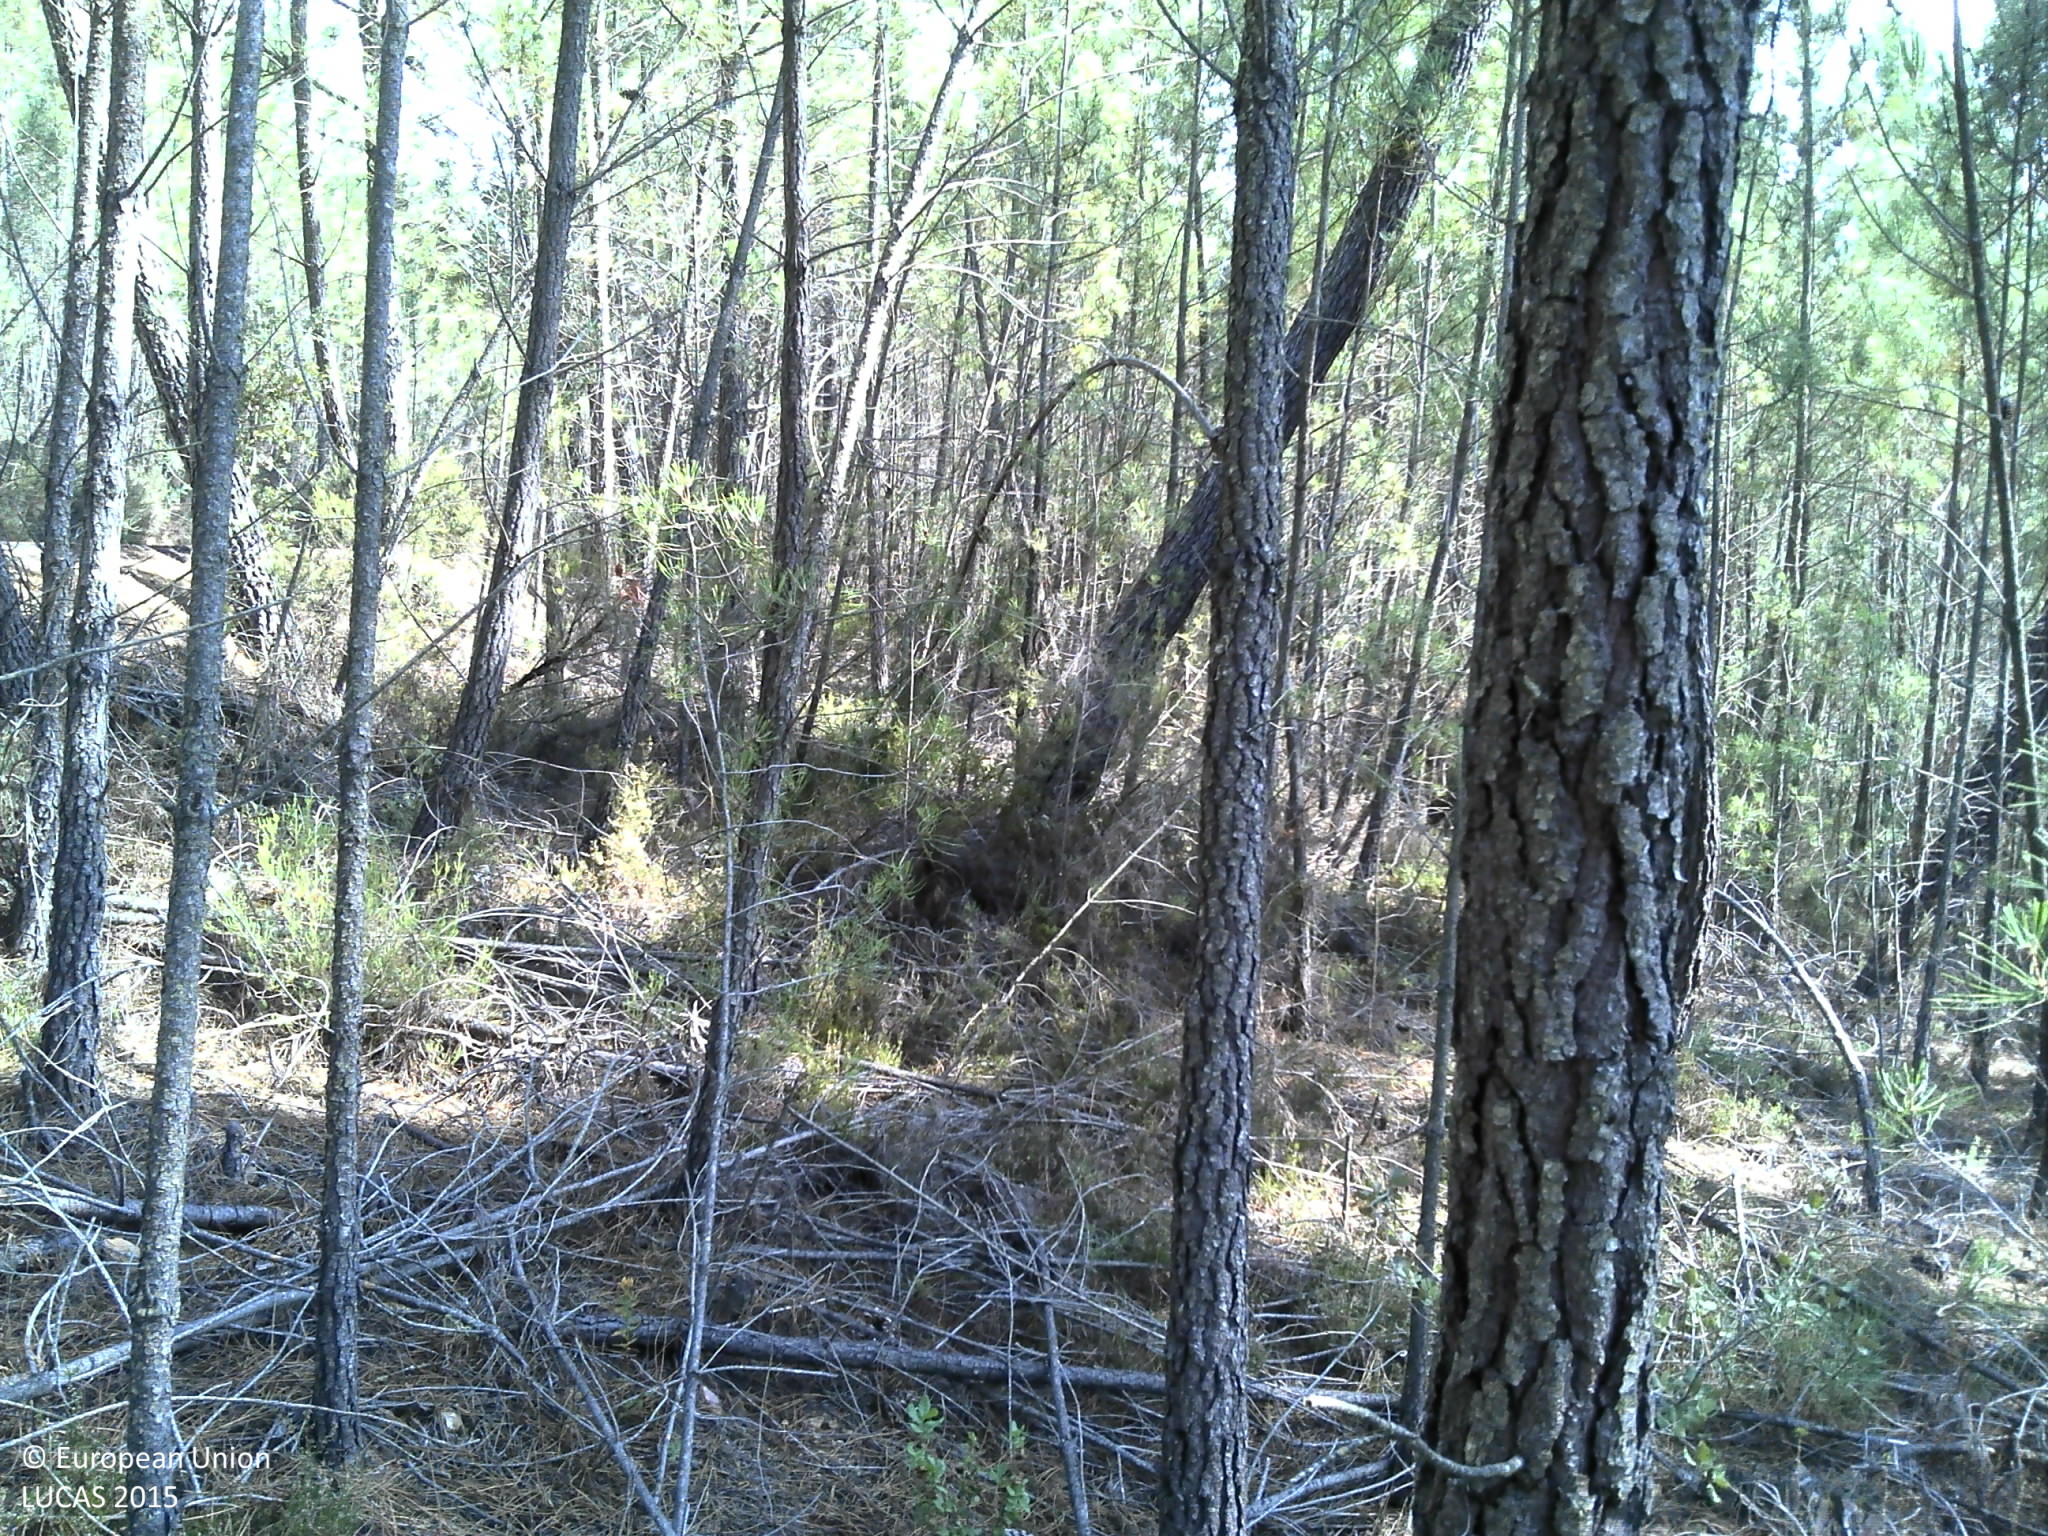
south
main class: Woodland
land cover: Pine dominated coniferous woodland
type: coniferous forest of the mediterranean region
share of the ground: 10 - 25 %
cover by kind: unconsolidated bare surface 65 %, shrubs 20 %, coniferous forest trees 15 %
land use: Forestry
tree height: > 5 m
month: July
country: PT
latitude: 39.9427
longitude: -7.8647
